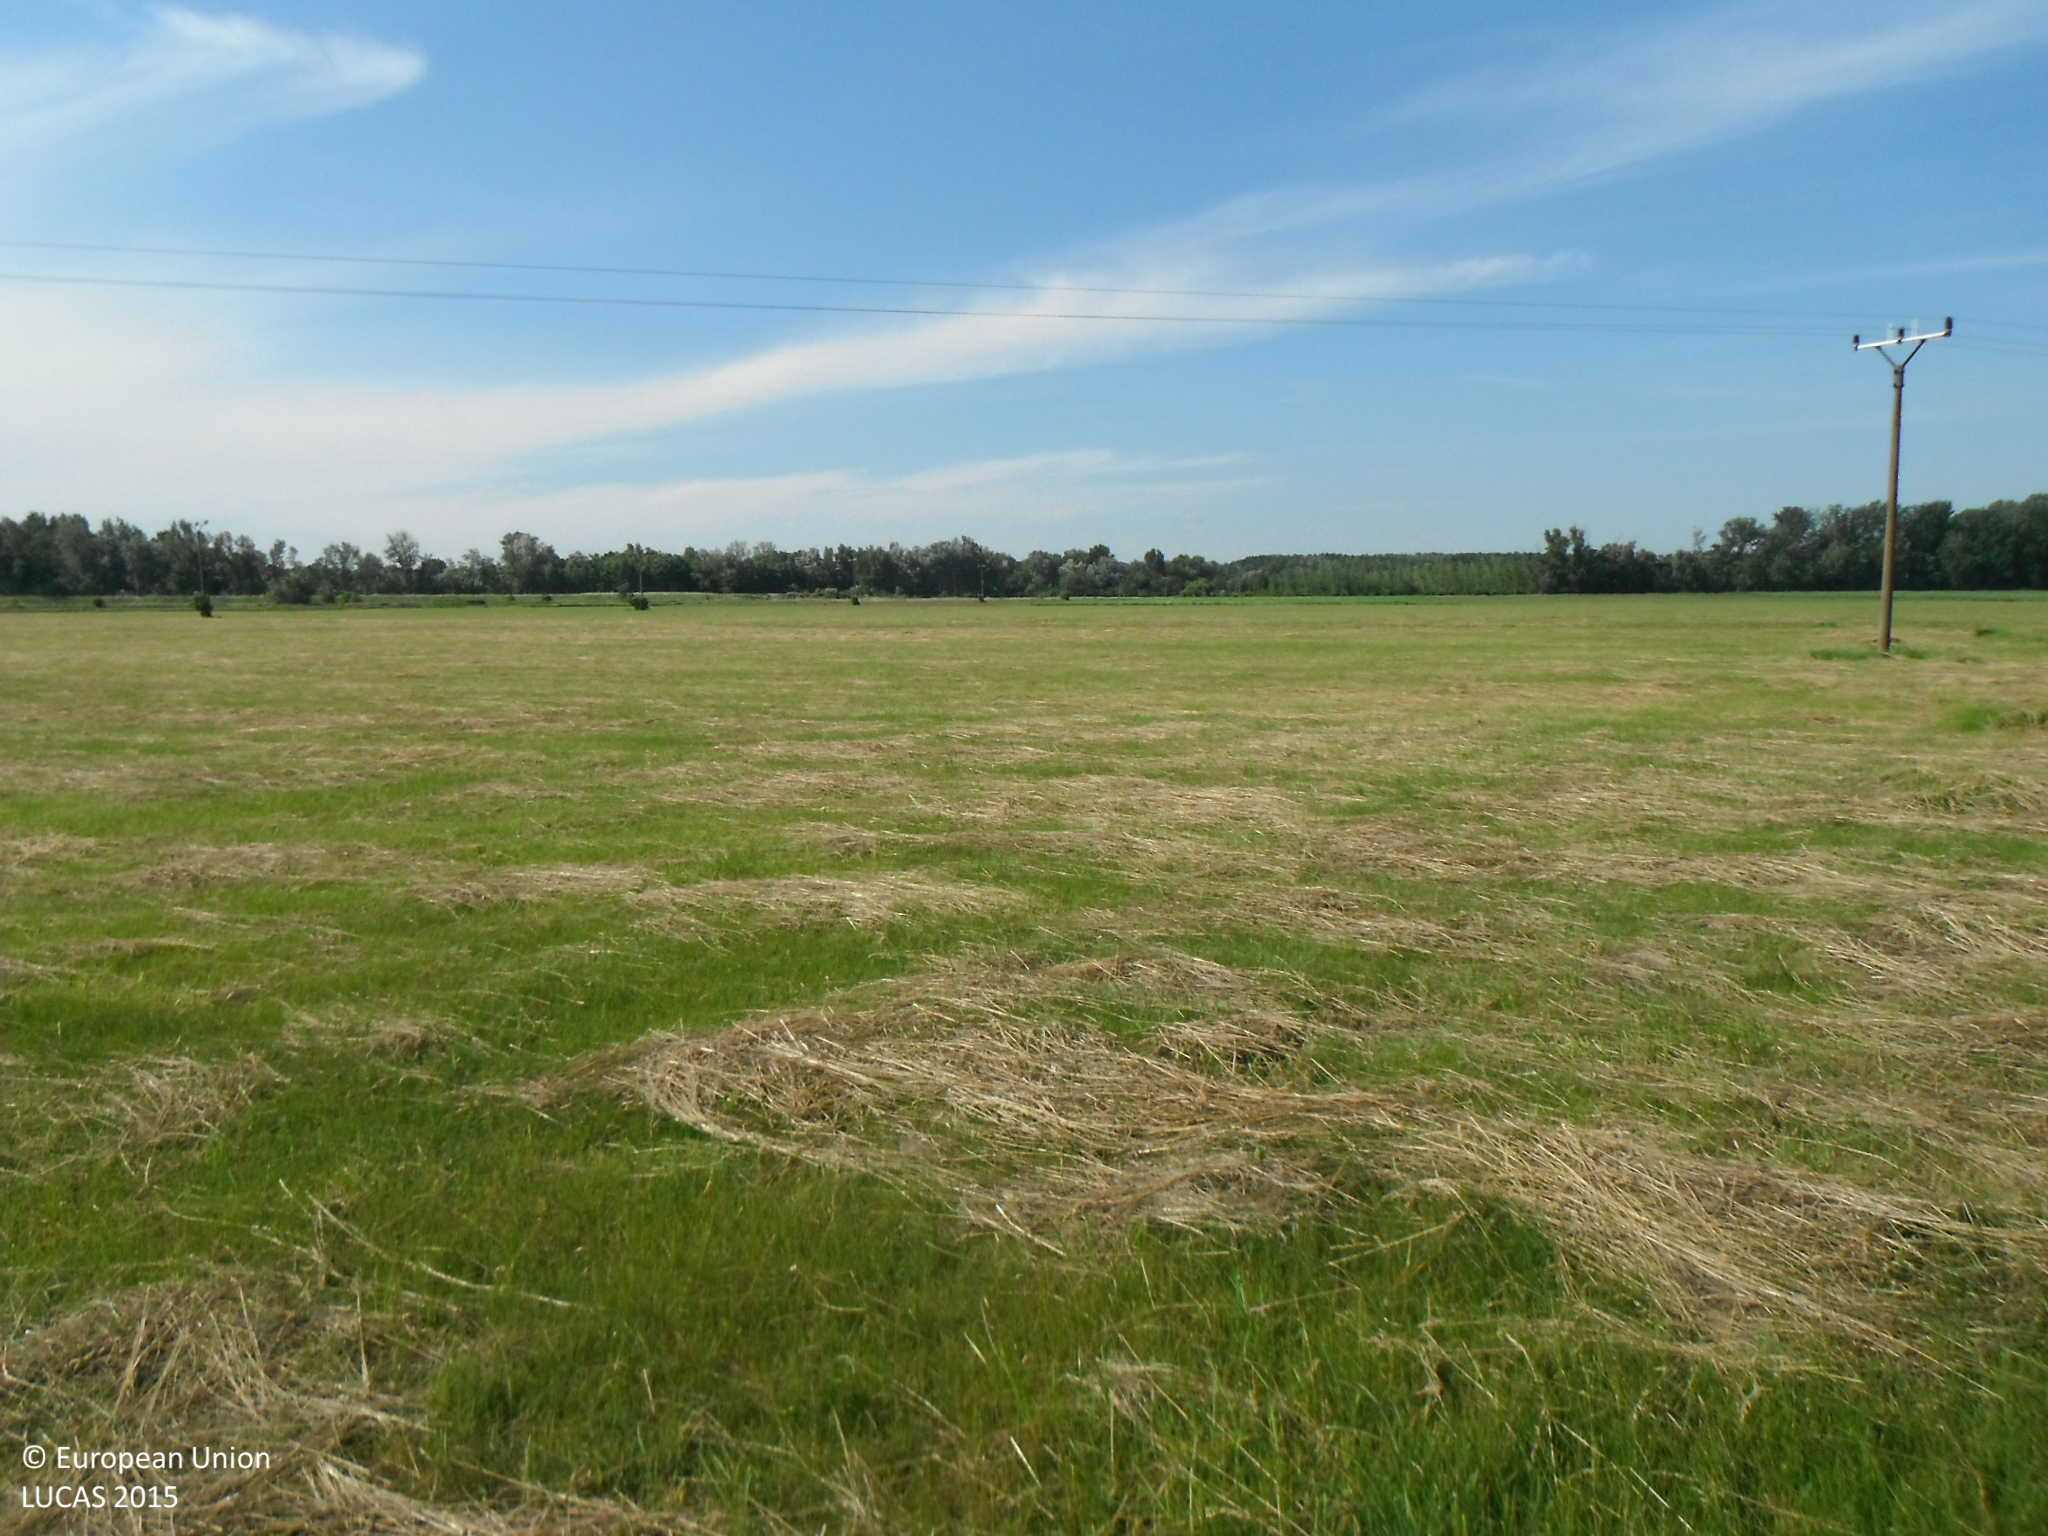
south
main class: Grassland
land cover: Grassland without tree/shrub cover
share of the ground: > 75 %
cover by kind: herbaceous plants 100 %
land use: Agriculture (excluding fallow land and kitchen gardens)
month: May
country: SK
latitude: 47.7905
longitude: 17.7123
